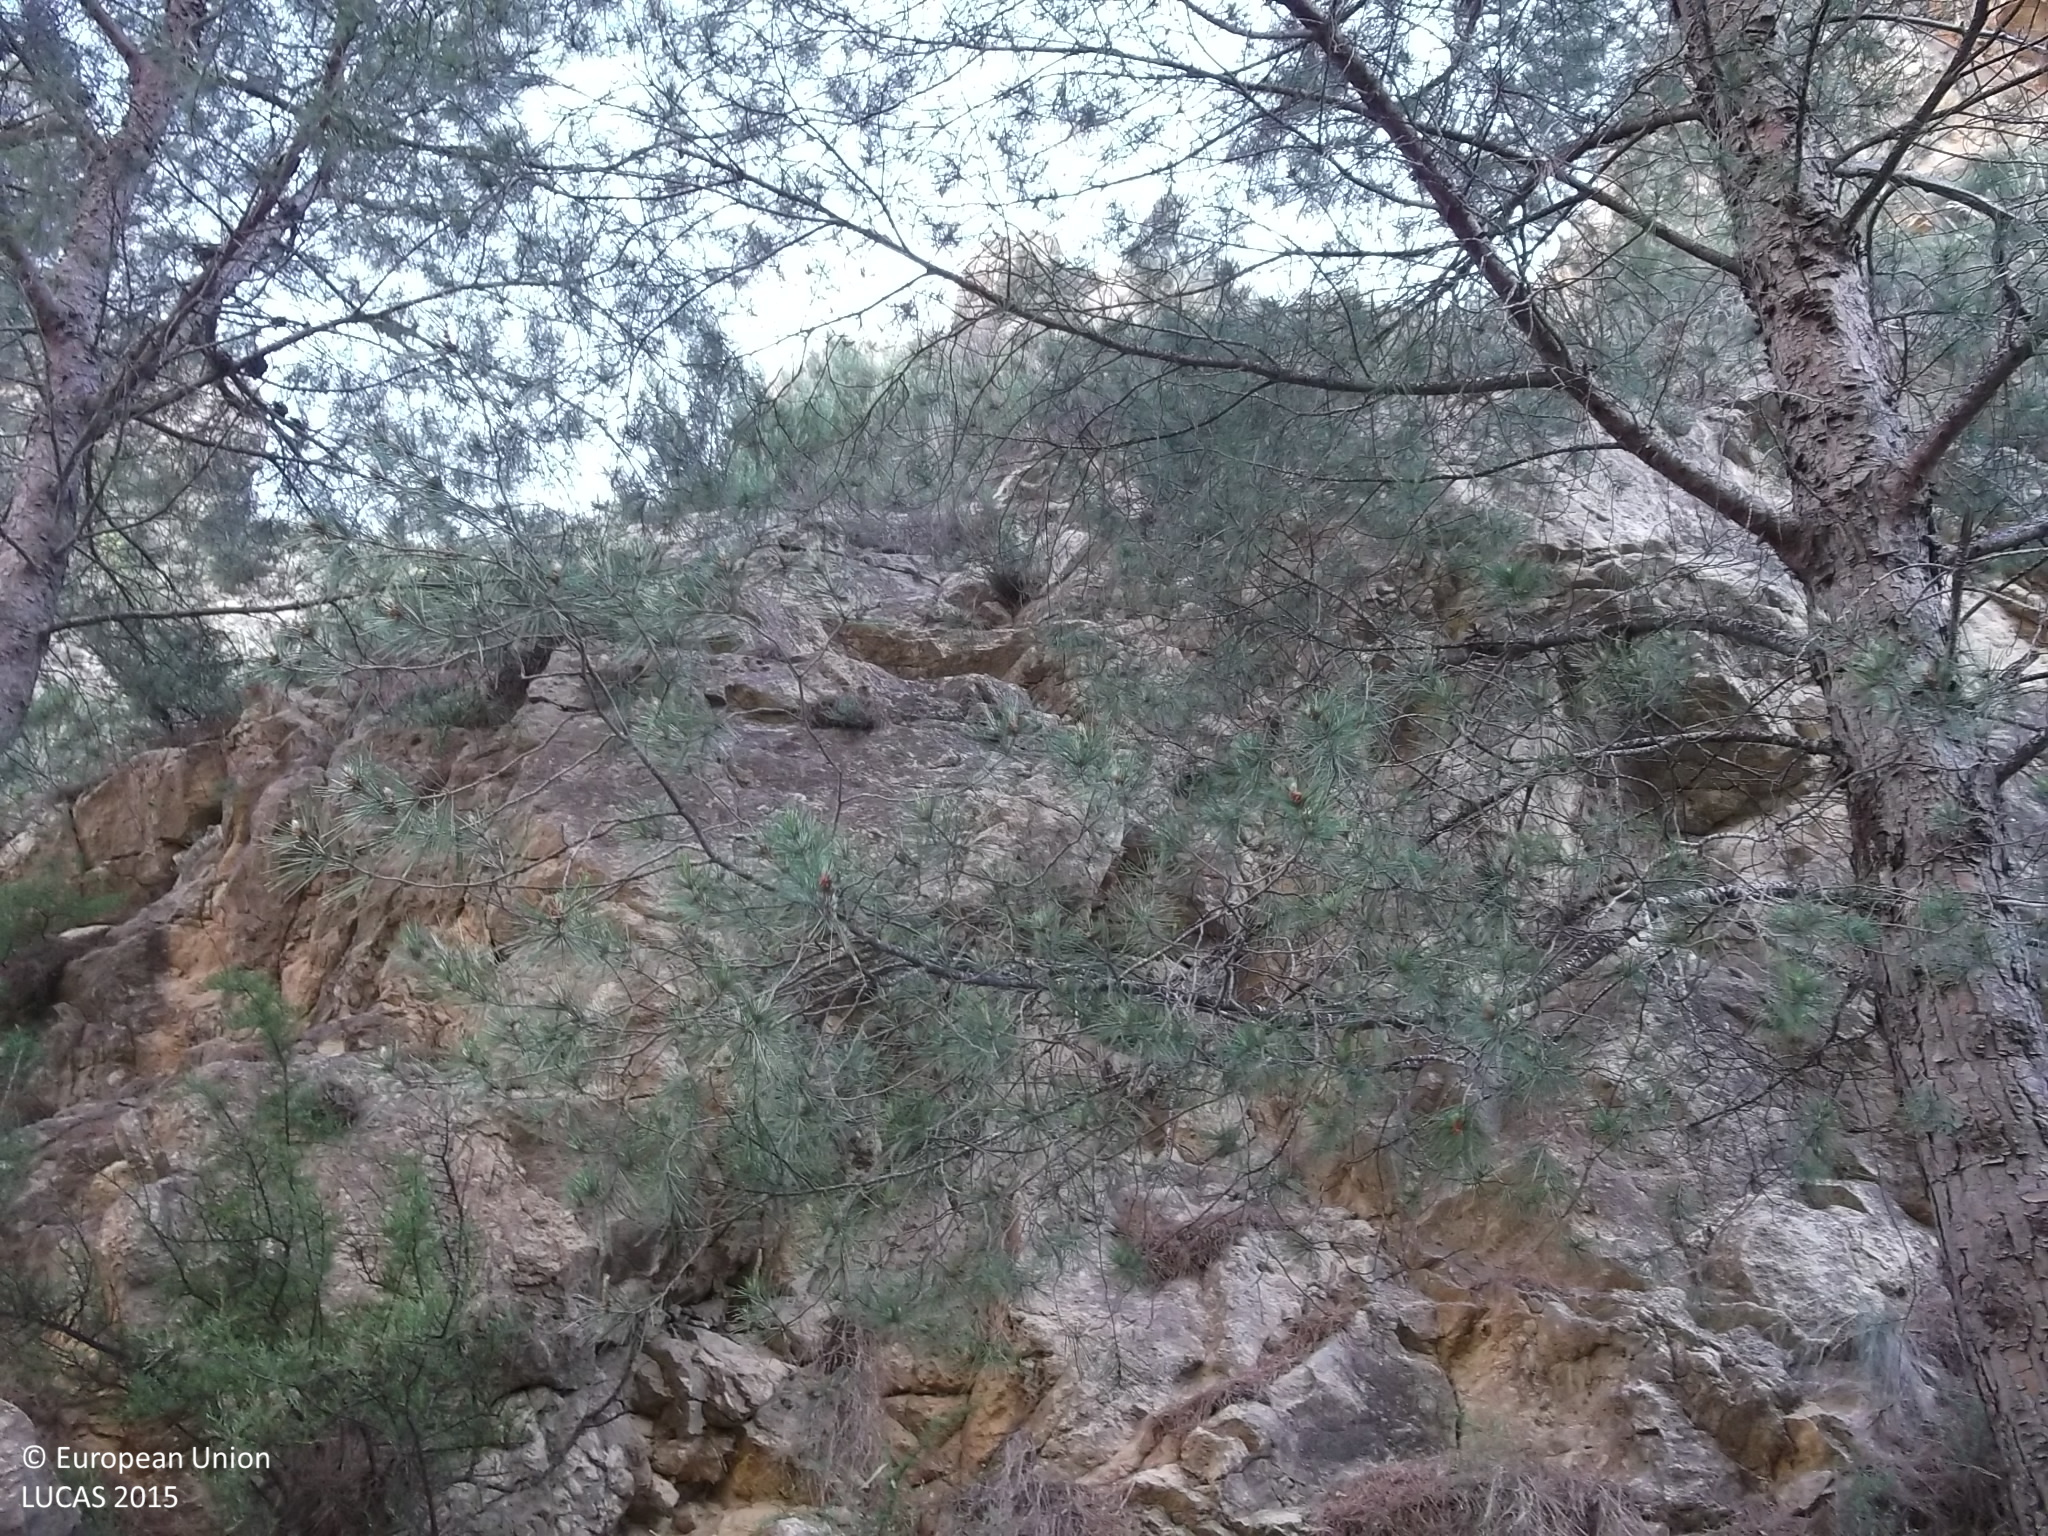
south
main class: Woodland
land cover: Pine dominated coniferous woodland
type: coniferous forest of the mediterranean region
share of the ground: 25 - 50 %
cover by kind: herbaceous plants 50 %, coniferous forest trees 25 %, shrubs 25 %
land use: Semi-natural and natural areas not in use
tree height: > 5 m
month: April
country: ES
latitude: 38.1487
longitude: -1.3179
